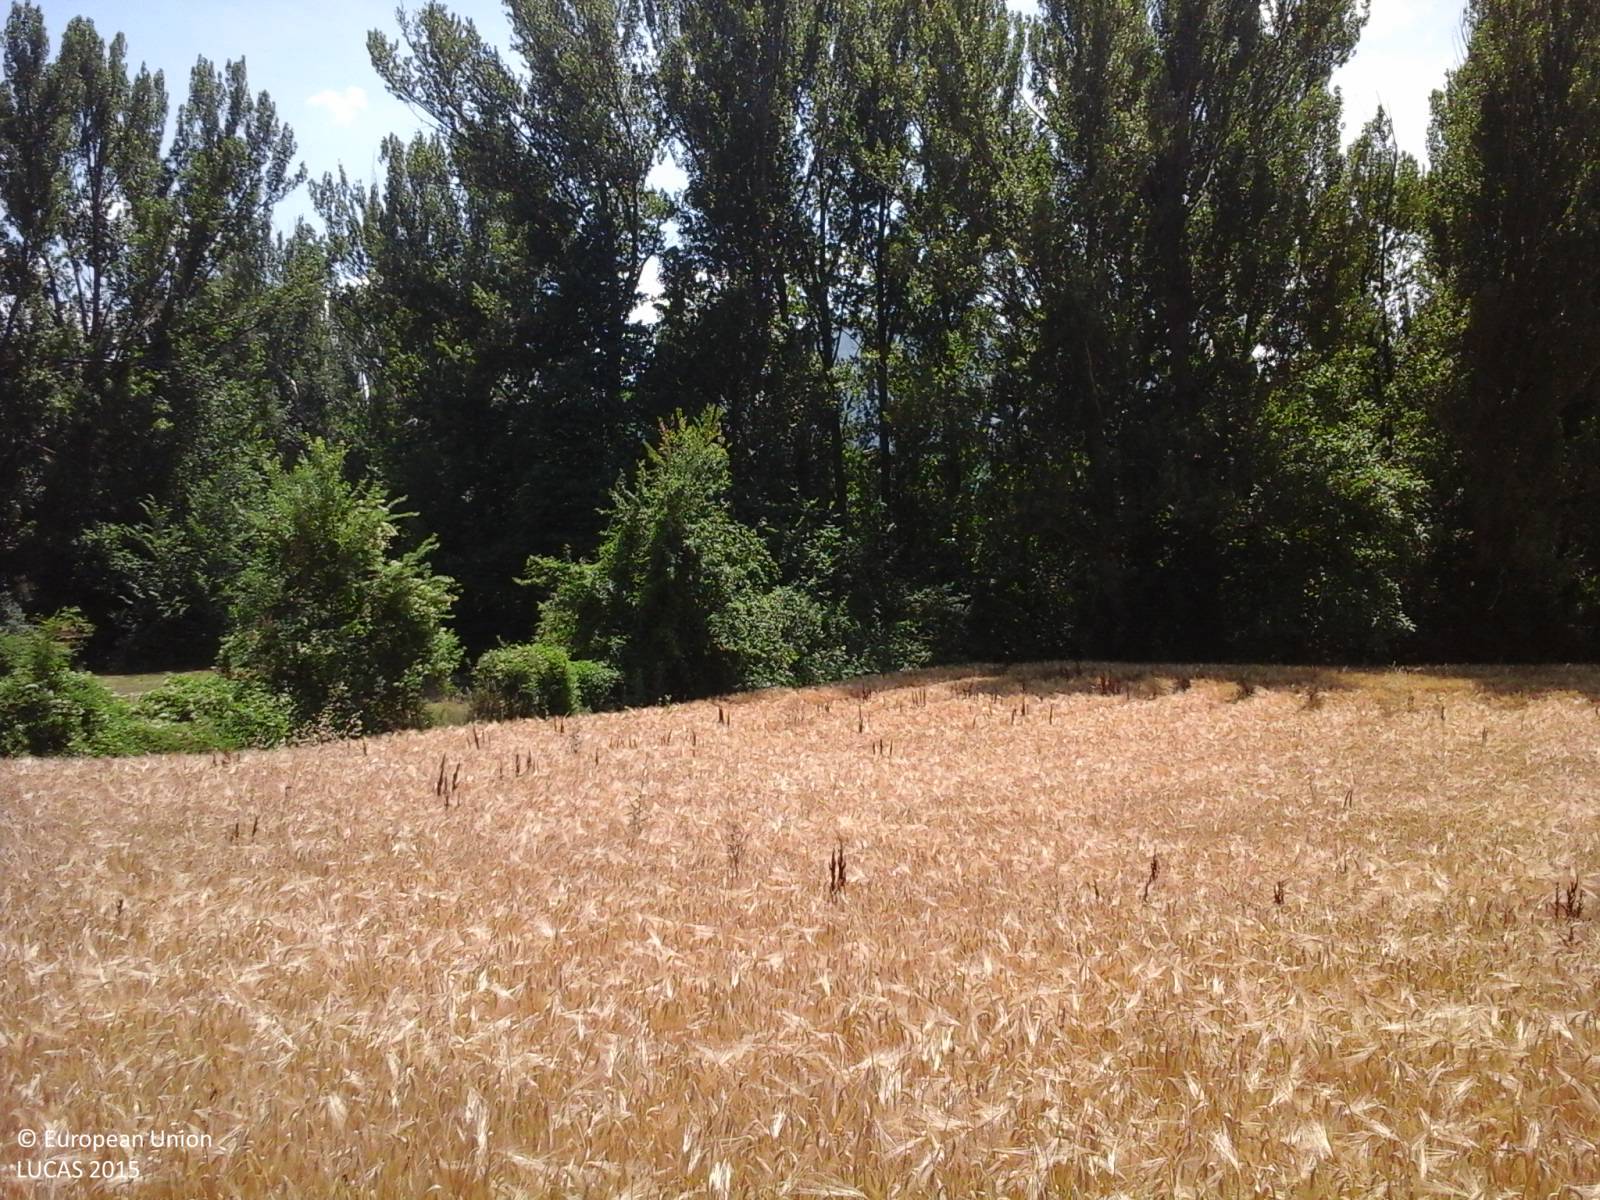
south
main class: Cropland
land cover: Barley
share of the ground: > 75 %
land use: Agriculture (excluding fallow land and kitchen gardens)
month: July
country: IT
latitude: 42.4381
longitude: 13.2840
